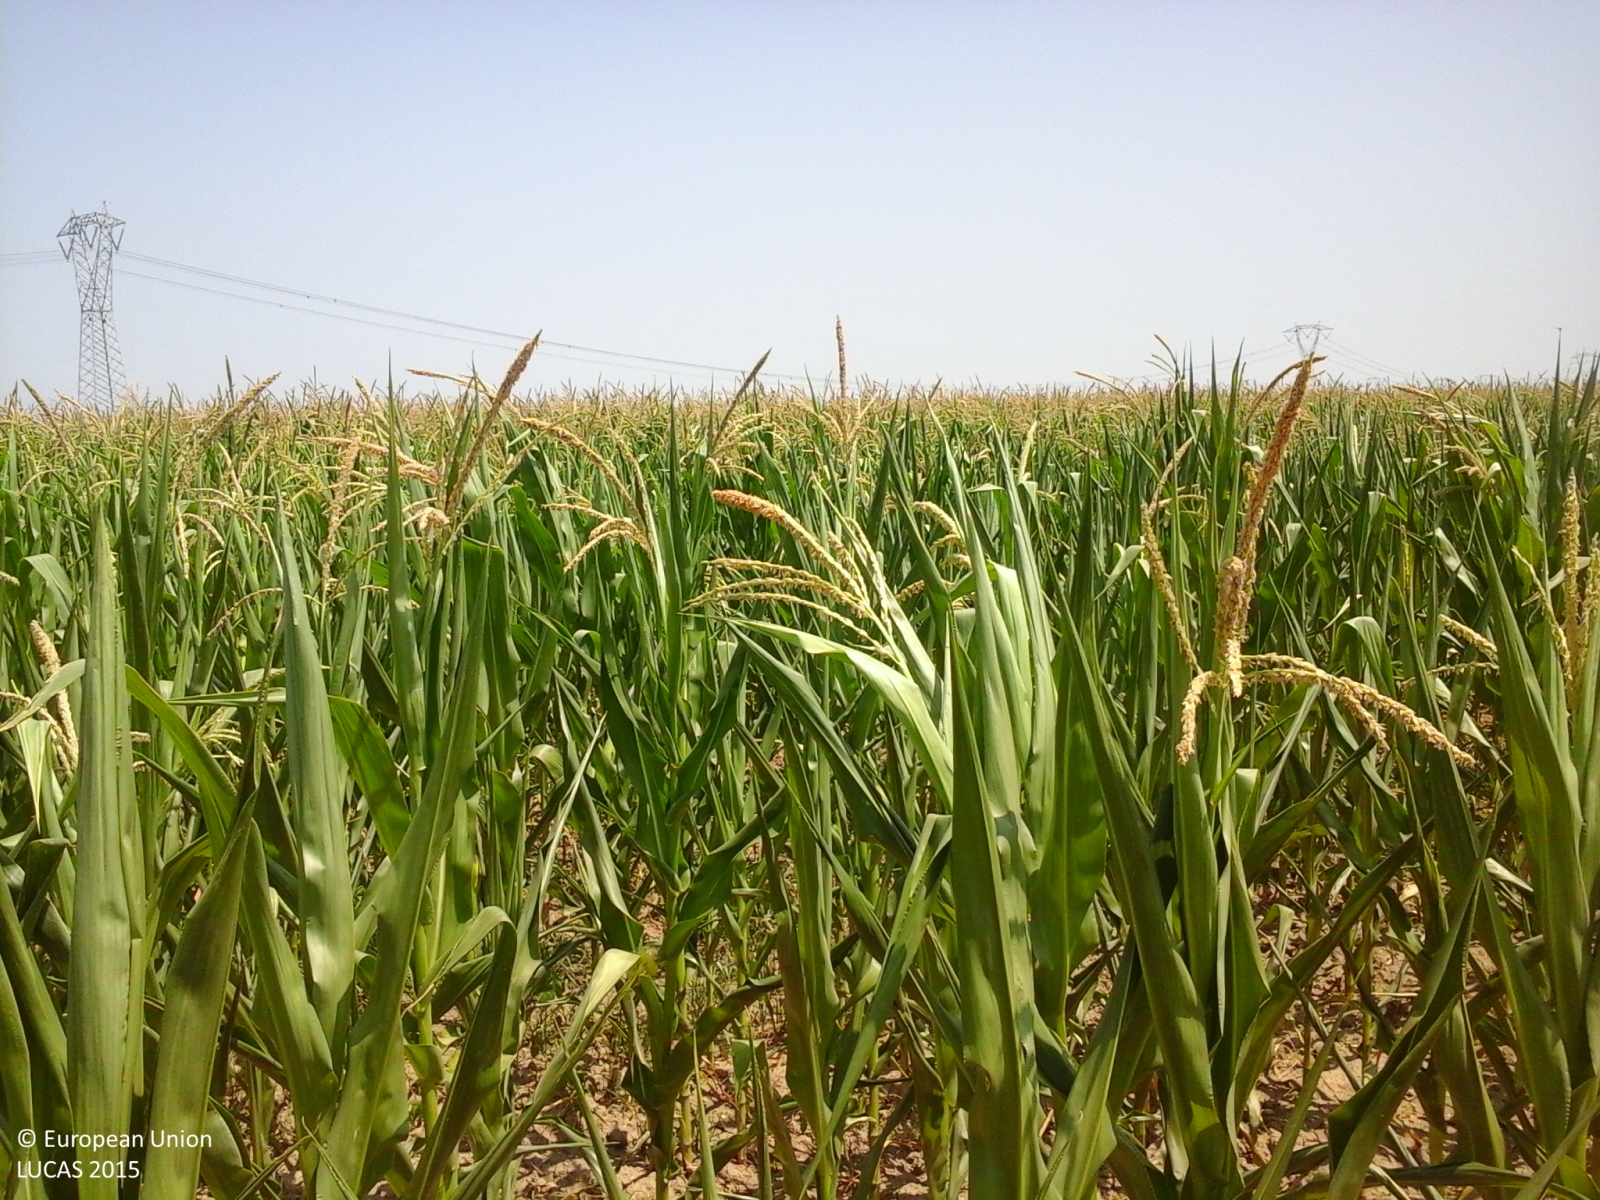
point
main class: Cropland
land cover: Maize
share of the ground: > 75 %
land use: Agriculture (excluding fallow land and kitchen gardens)
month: July
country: IT
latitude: 45.3021
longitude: 10.9293
